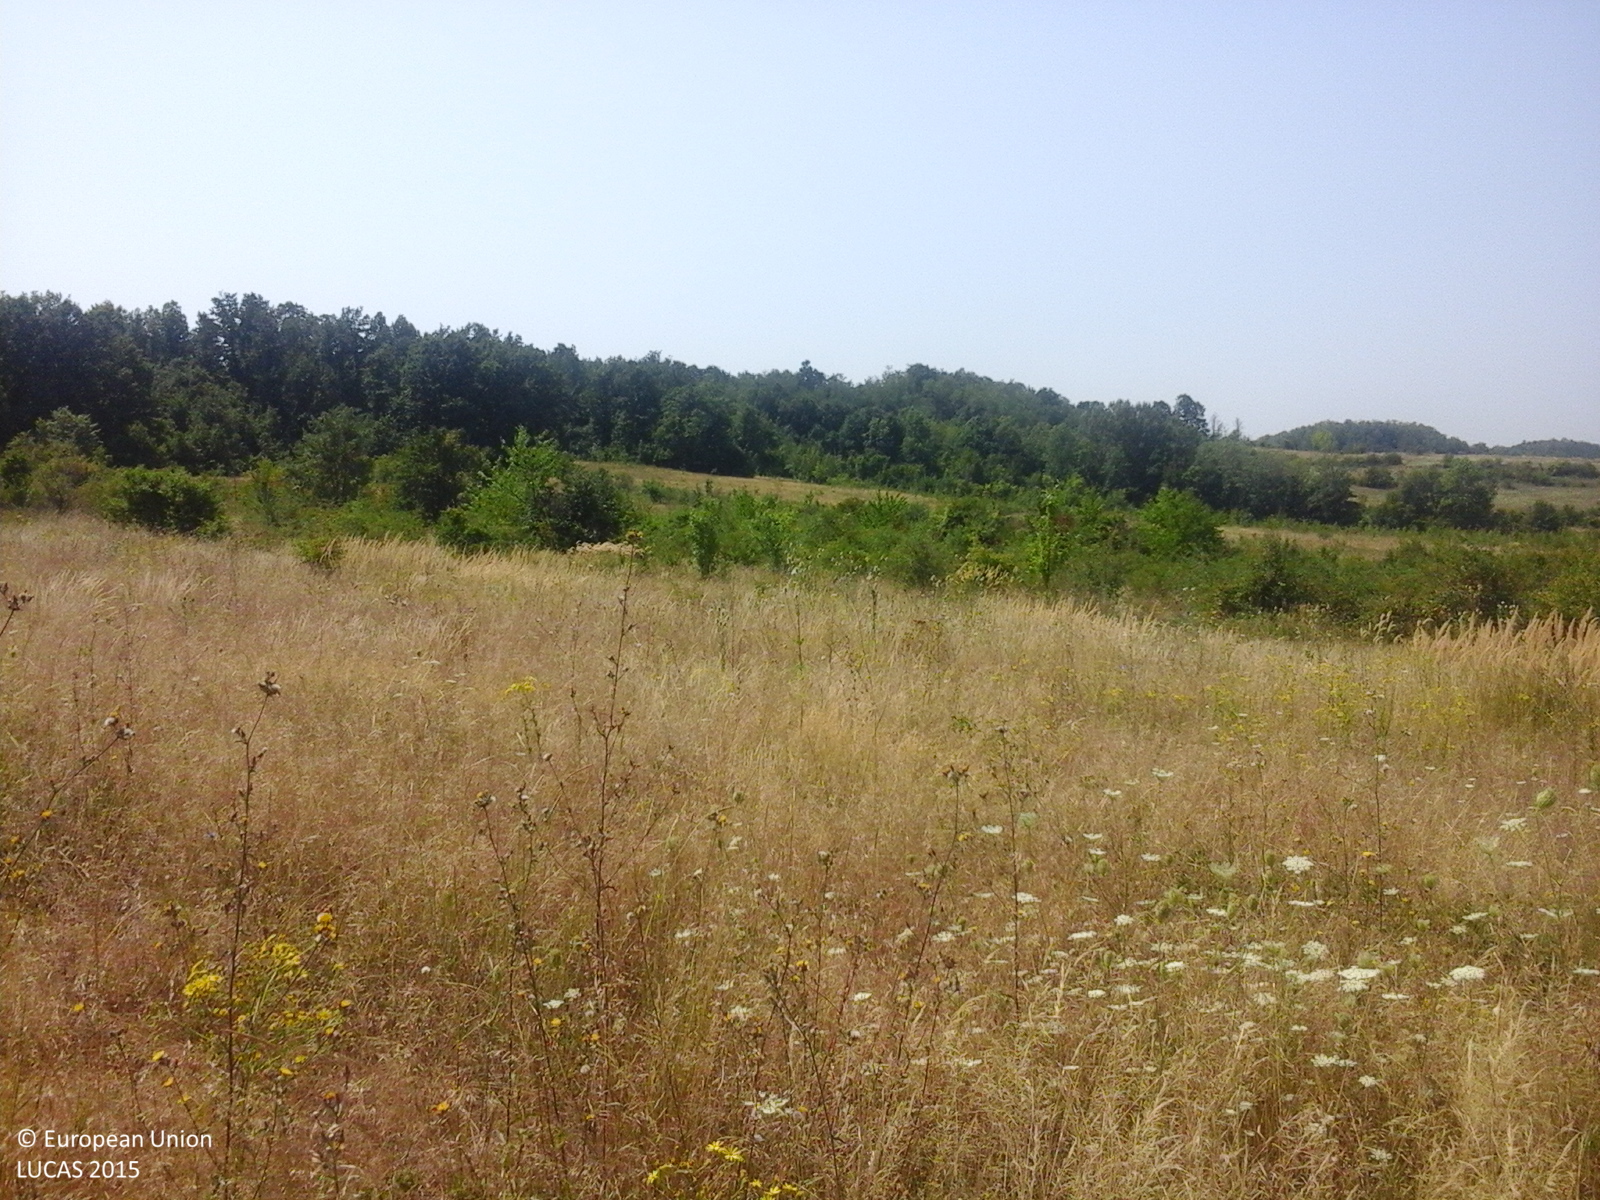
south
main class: Grassland
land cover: Grassland without tree/shrub cover
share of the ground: > 75 %
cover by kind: herbaceous plants 100 %
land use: Agriculture (excluding fallow land and kitchen gardens)
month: August
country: RO
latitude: 44.5738
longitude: 23.1065
